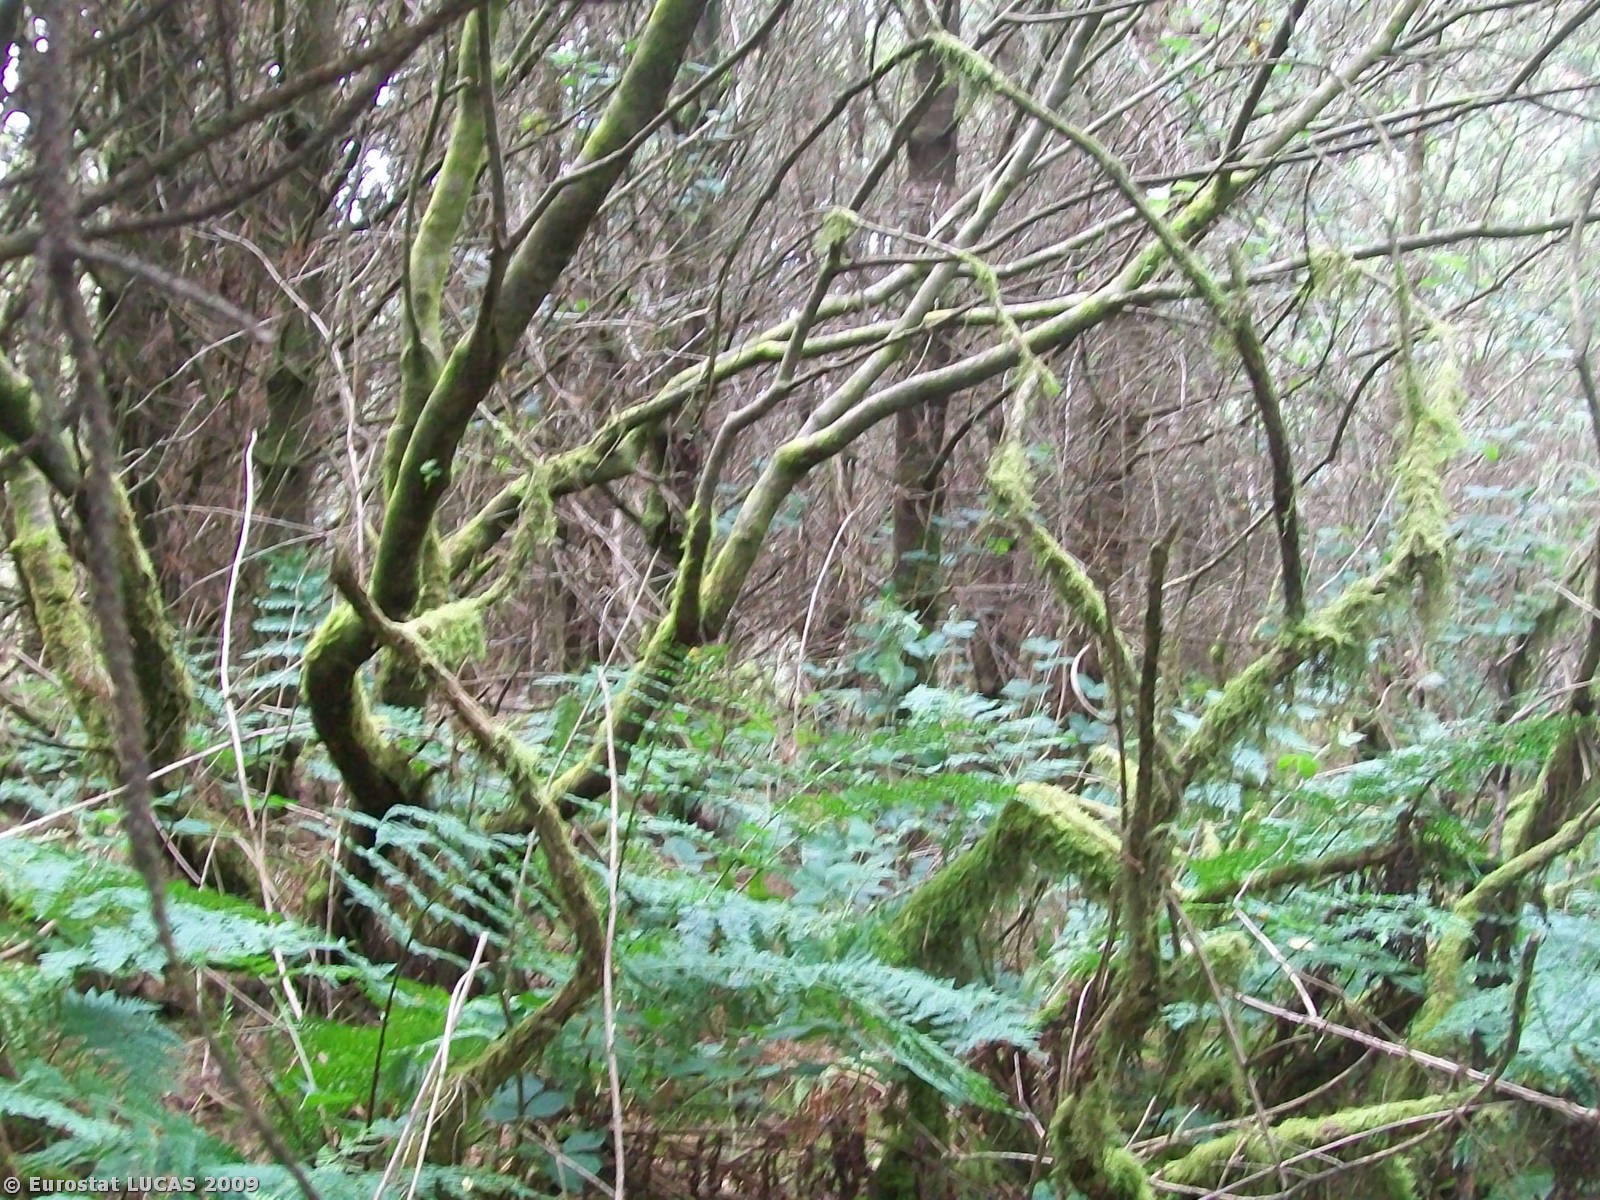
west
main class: Woodland
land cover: Coniferous woodland
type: plantations and self-sown exotic forest
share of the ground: > 75 %
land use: Forestry
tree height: > 5 m
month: July
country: GB
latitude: 55.2061
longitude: -6.3173
